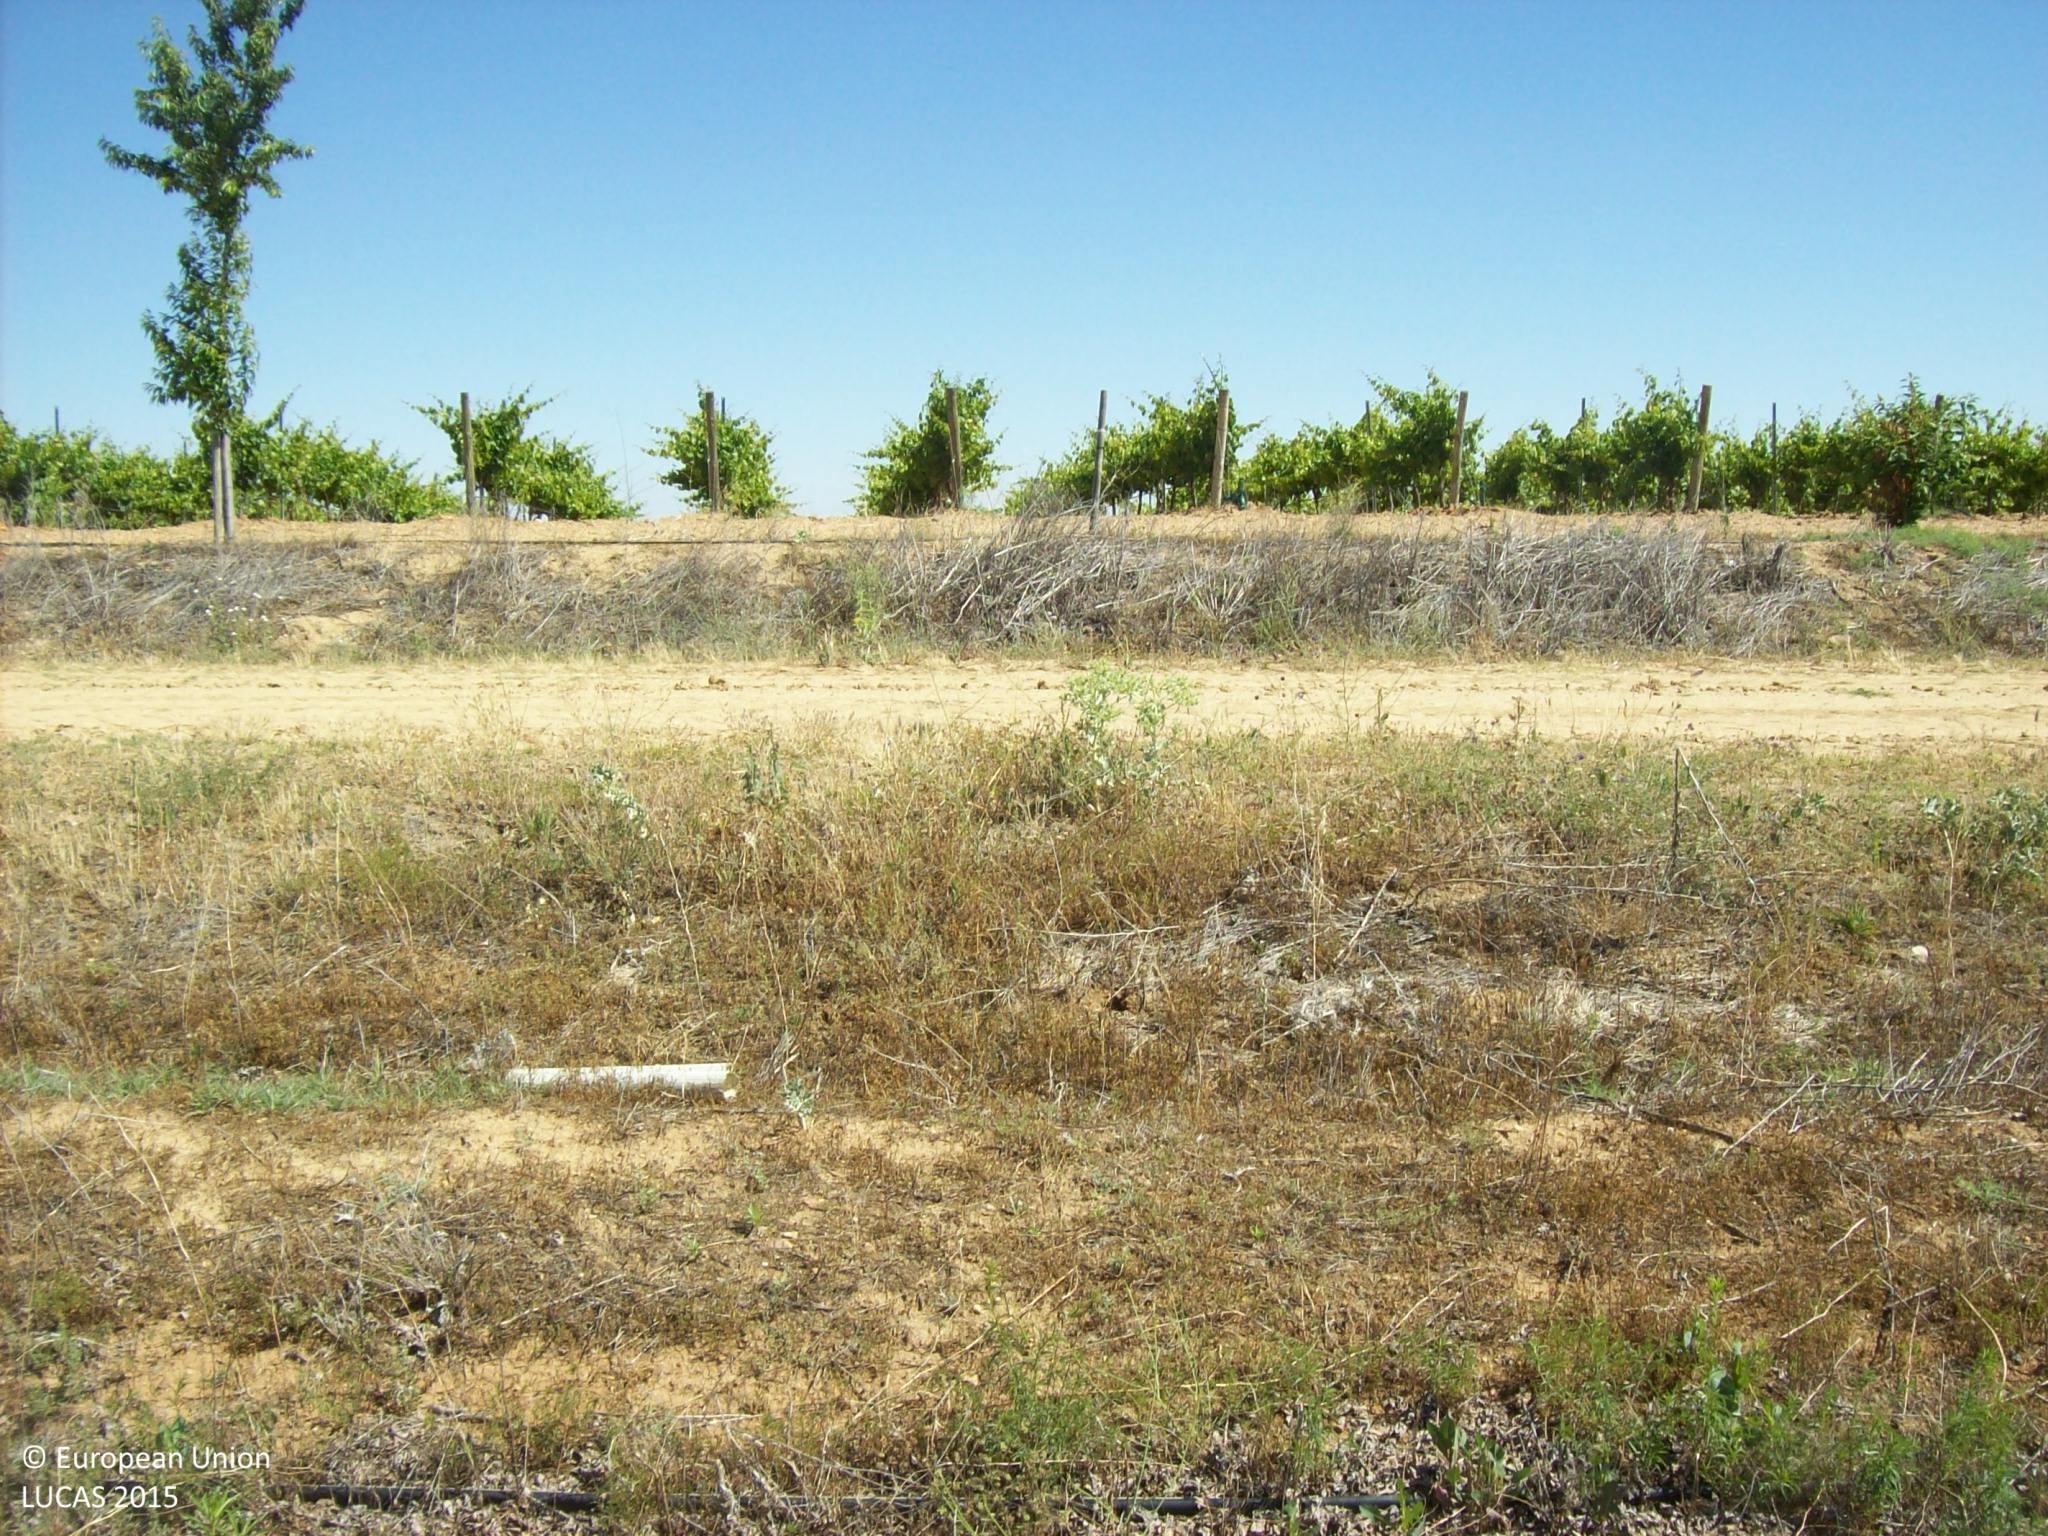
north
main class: Cropland
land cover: Vineyards
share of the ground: 25 - 50 %
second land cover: Other bare soil
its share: > 75 %
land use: Agriculture (excluding fallow land and kitchen gardens)
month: June
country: ES
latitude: 41.2688
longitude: -5.0267
